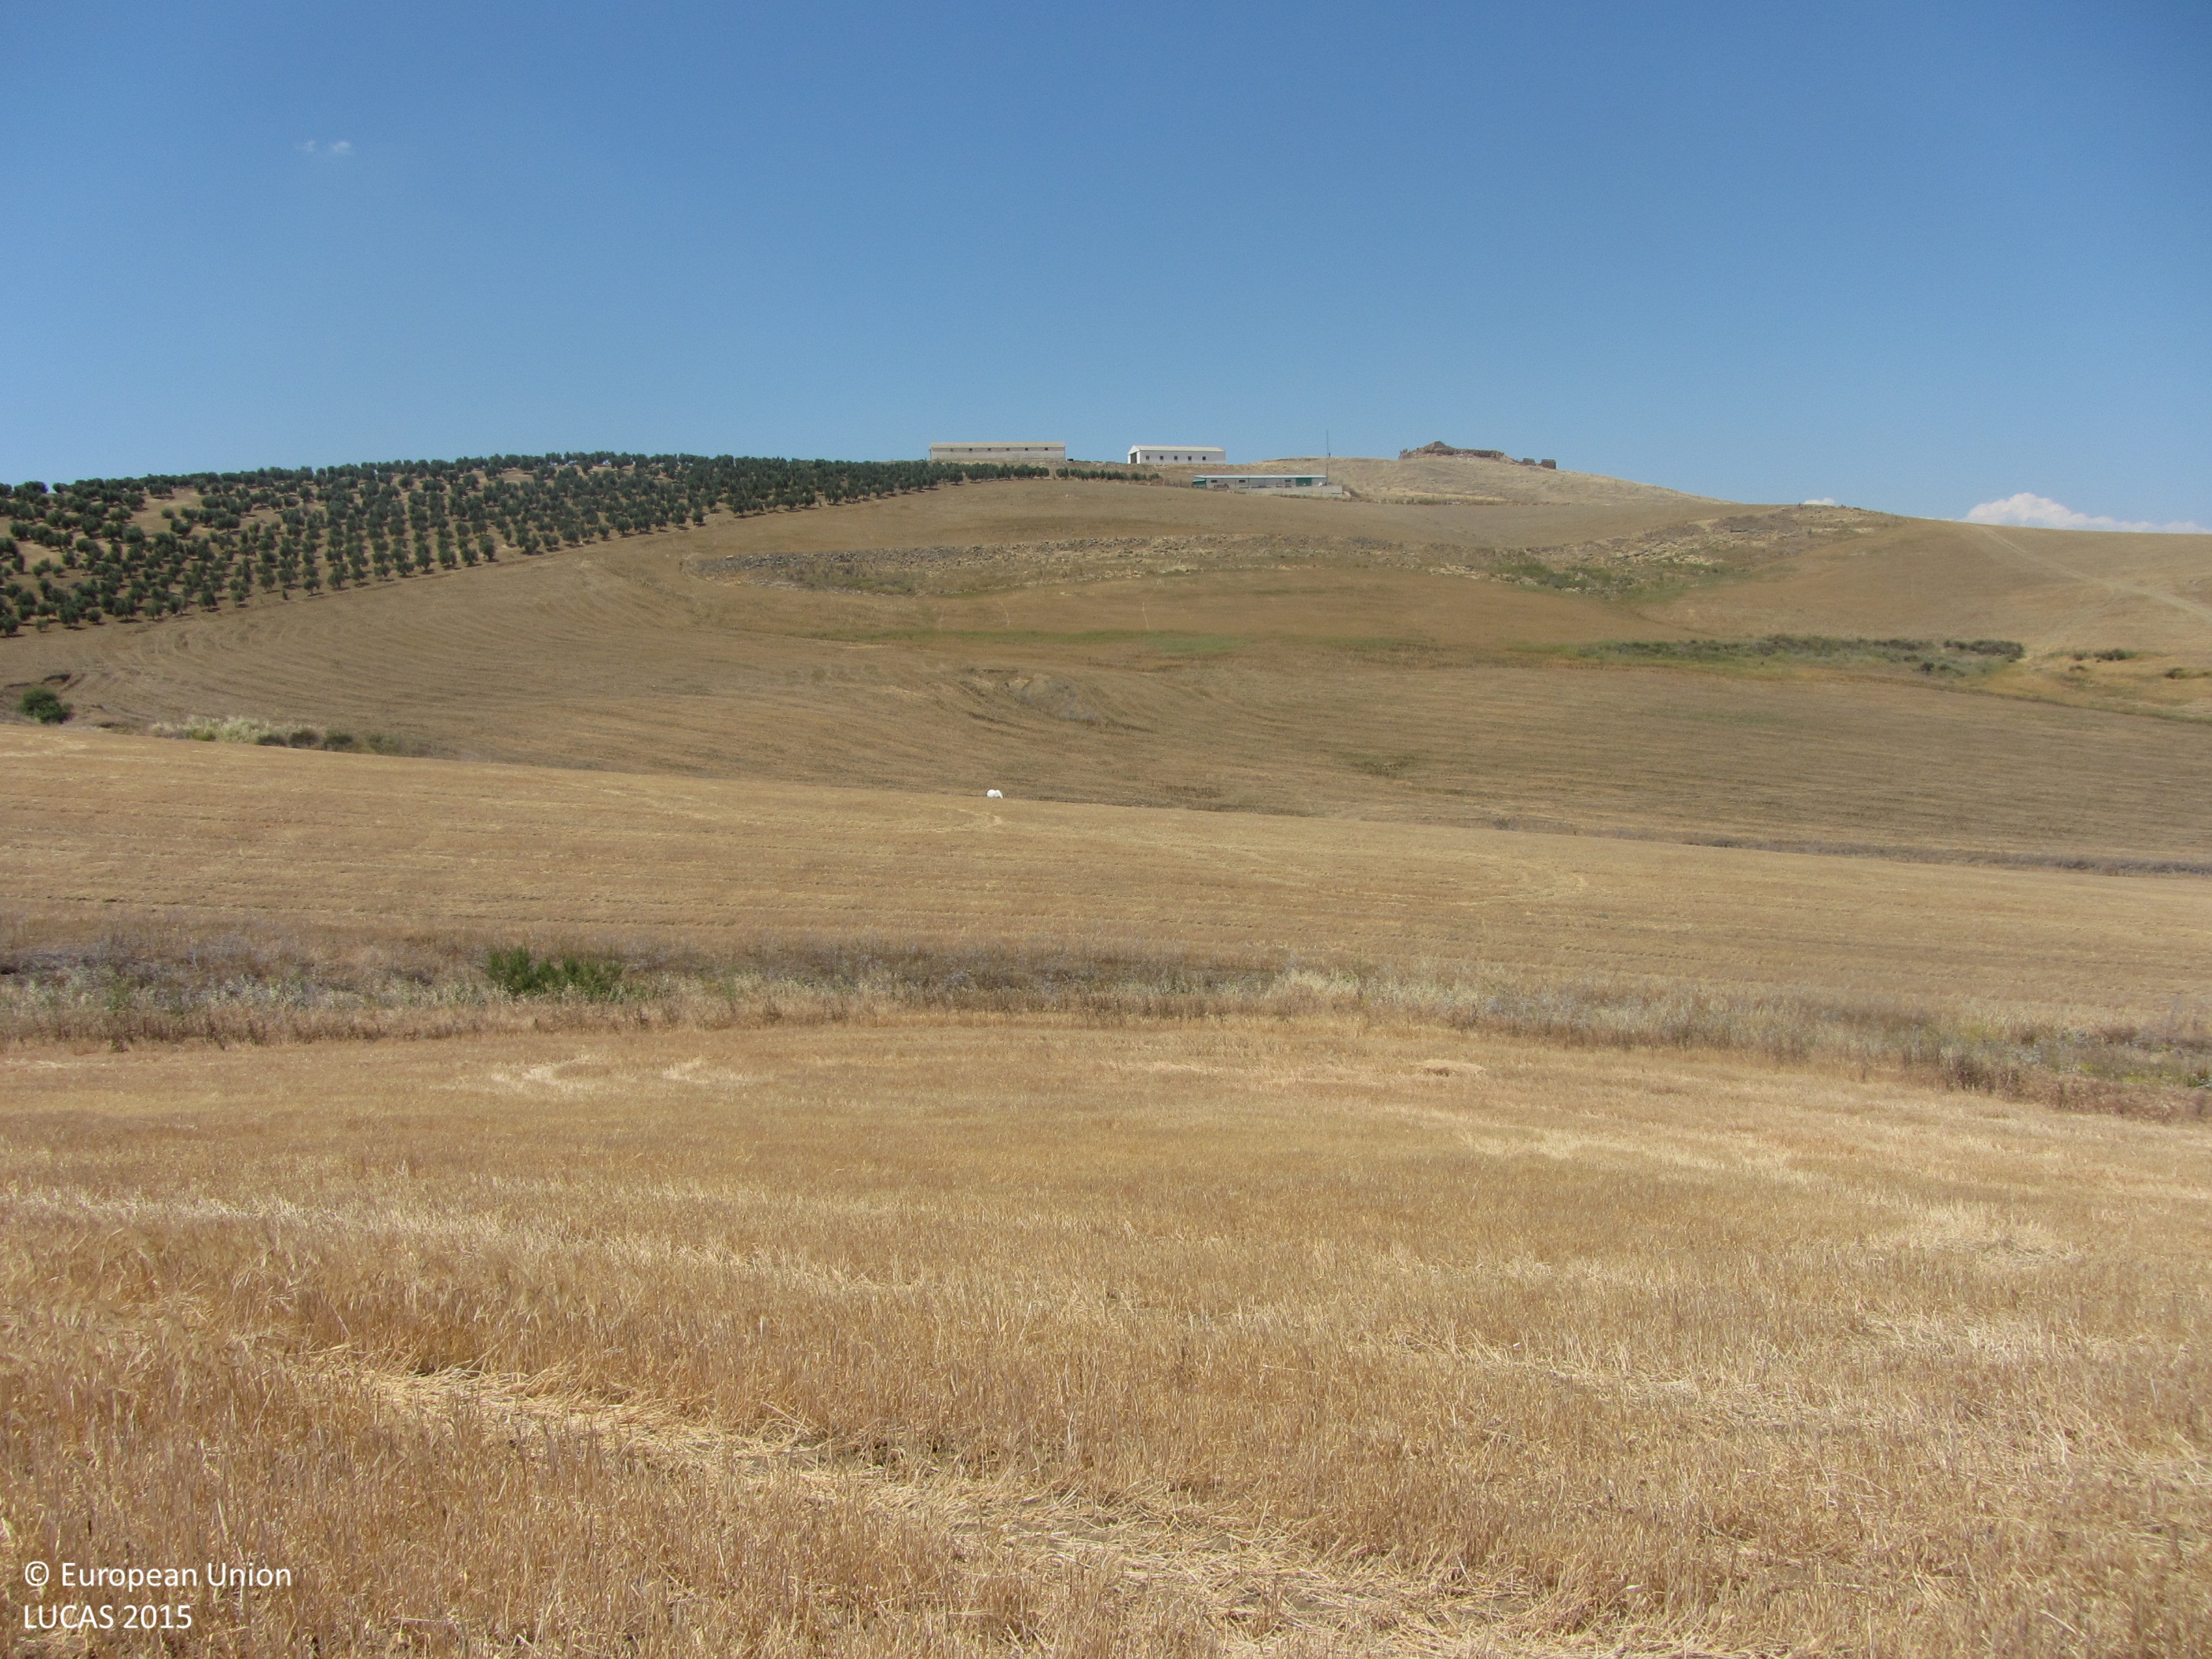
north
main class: Cropland
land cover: Barley
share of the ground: < 10 %
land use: Agriculture (excluding fallow land and kitchen gardens)
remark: Harvested field
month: June
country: ES
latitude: 37.8903
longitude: -3.8186
